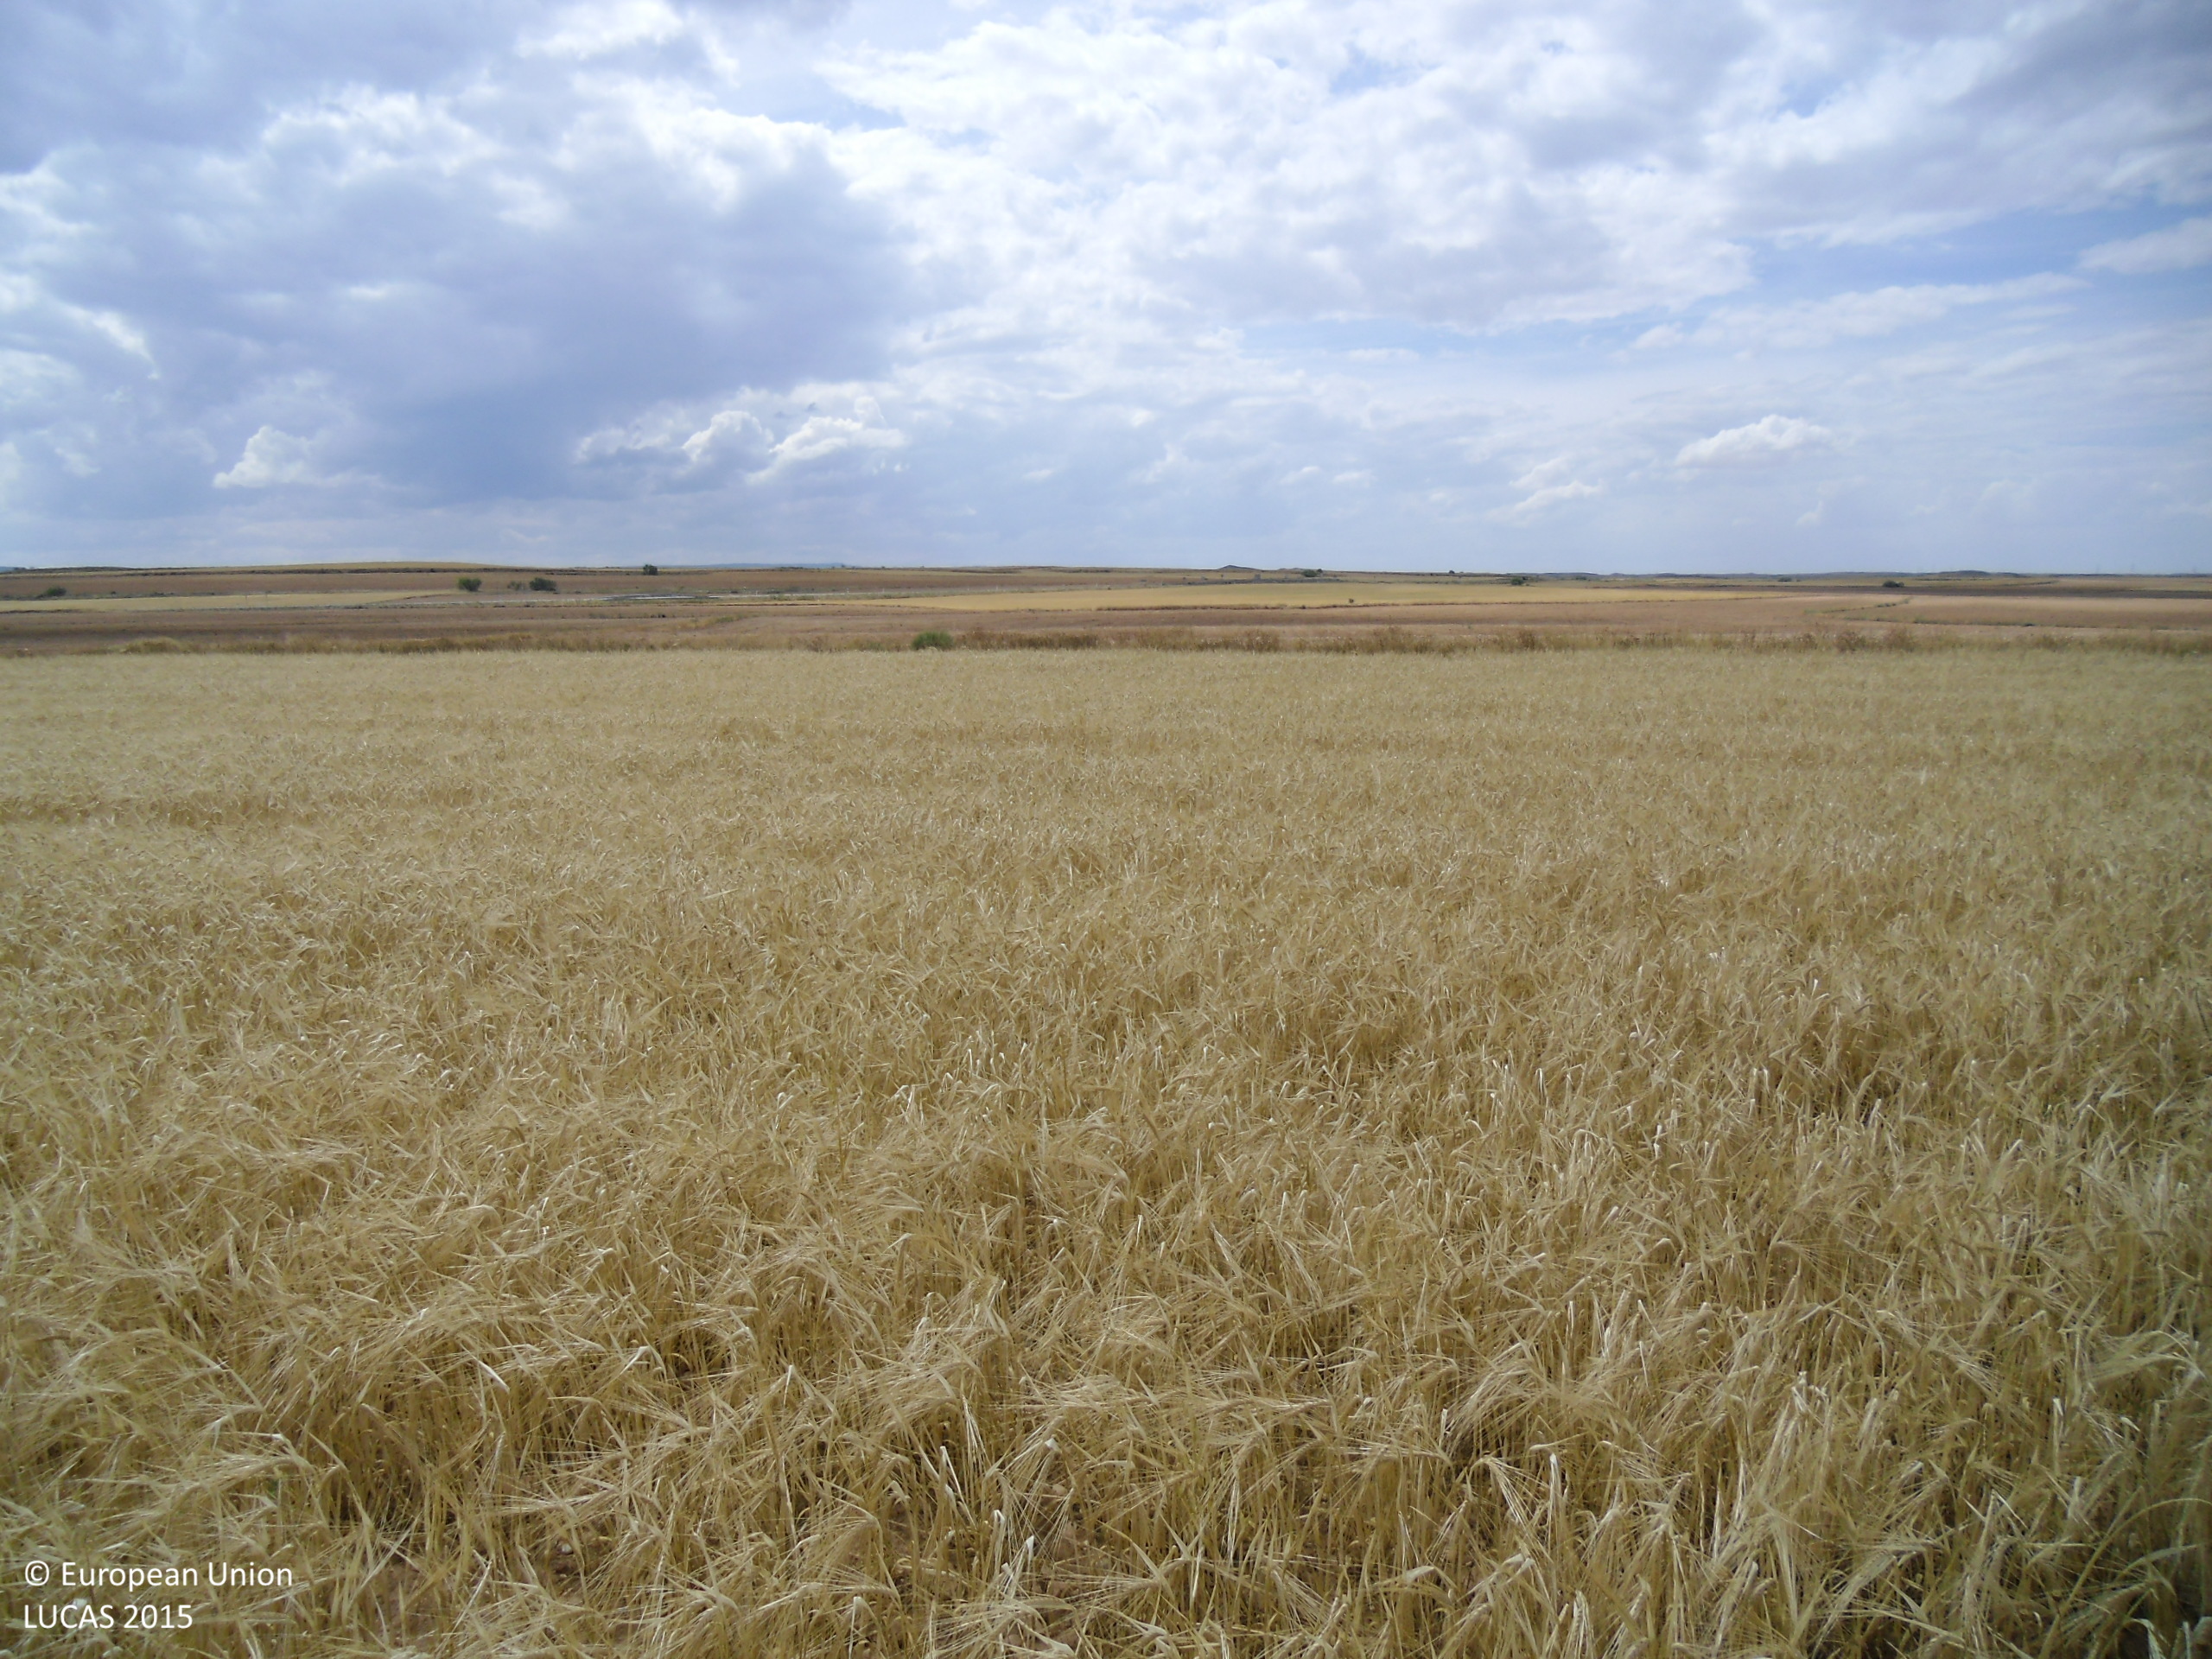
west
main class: Cropland
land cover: Rye
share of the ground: > 75 %
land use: Agriculture (excluding fallow land and kitchen gardens)
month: June
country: ES
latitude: 41.1224
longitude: -0.3397
